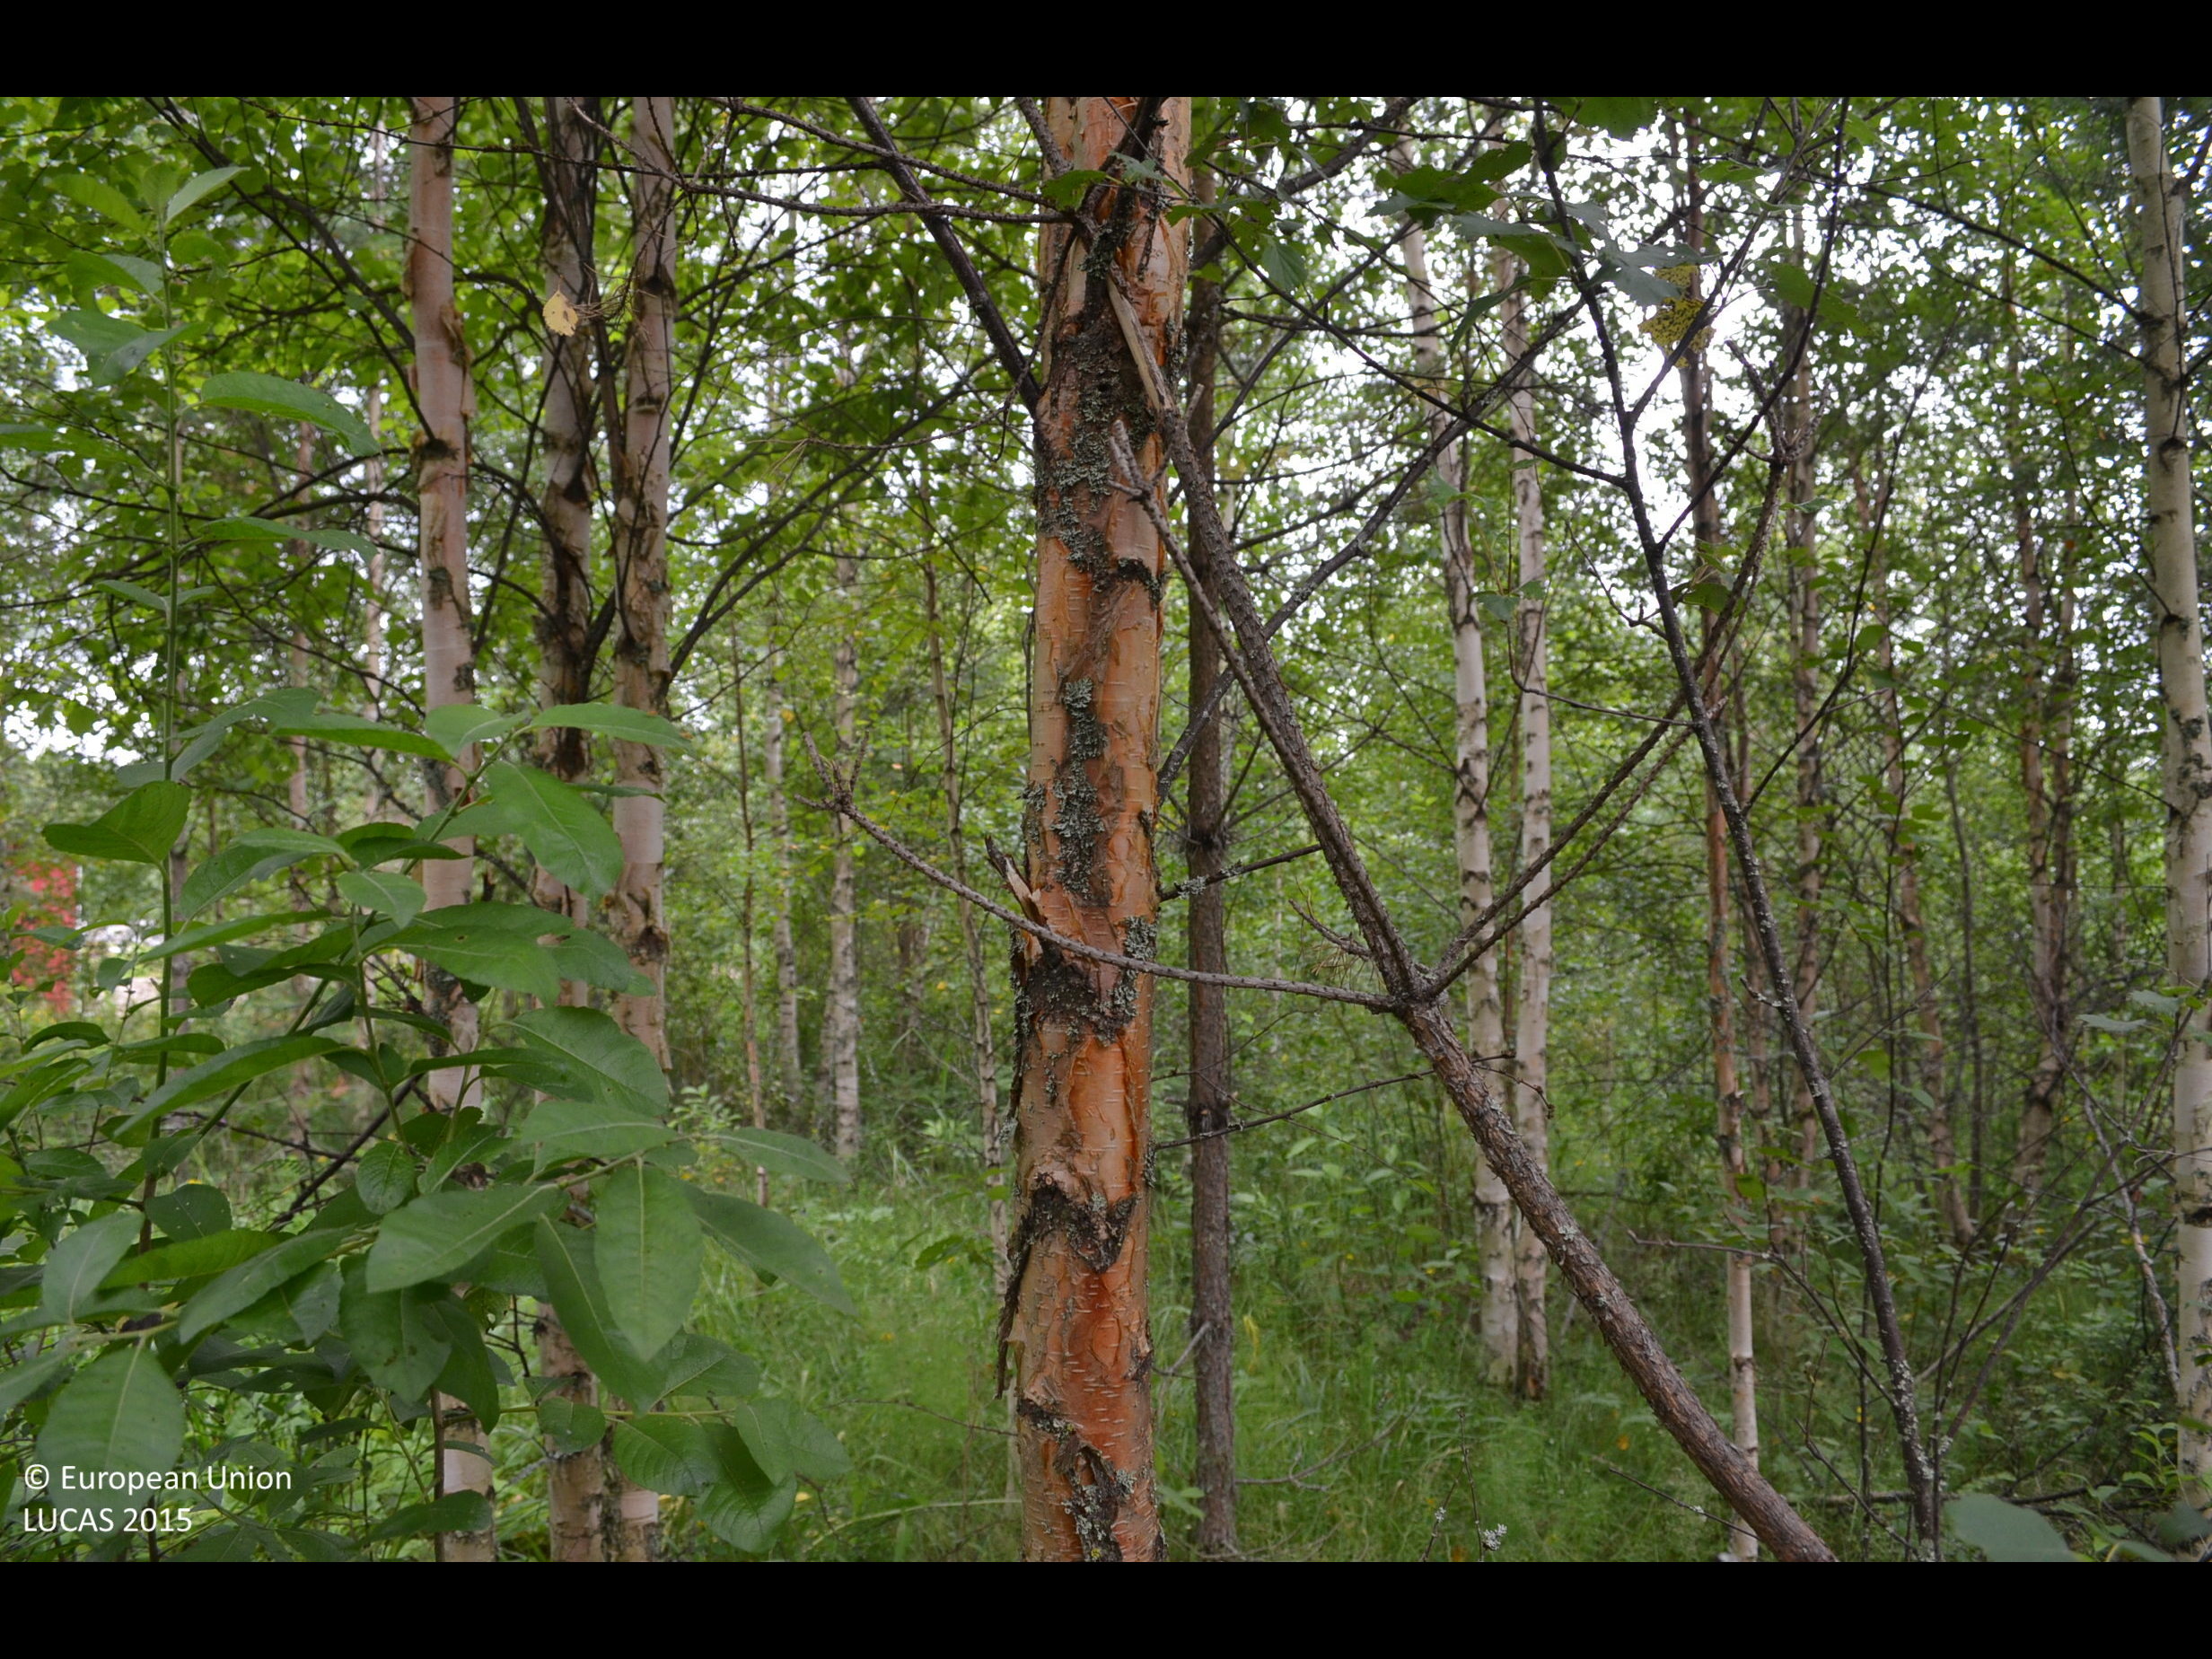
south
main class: Woodland
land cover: Pine dominated mixed woodland
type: boreal forest
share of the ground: 50 - 75 %
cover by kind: coniferous forest trees 30 %, broadleaved forest trees 30 %, herbaceous plants 30 %, shrubs 10 %
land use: Forestry
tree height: > 5 m
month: August
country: FI
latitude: 61.8776
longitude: 24.2197
